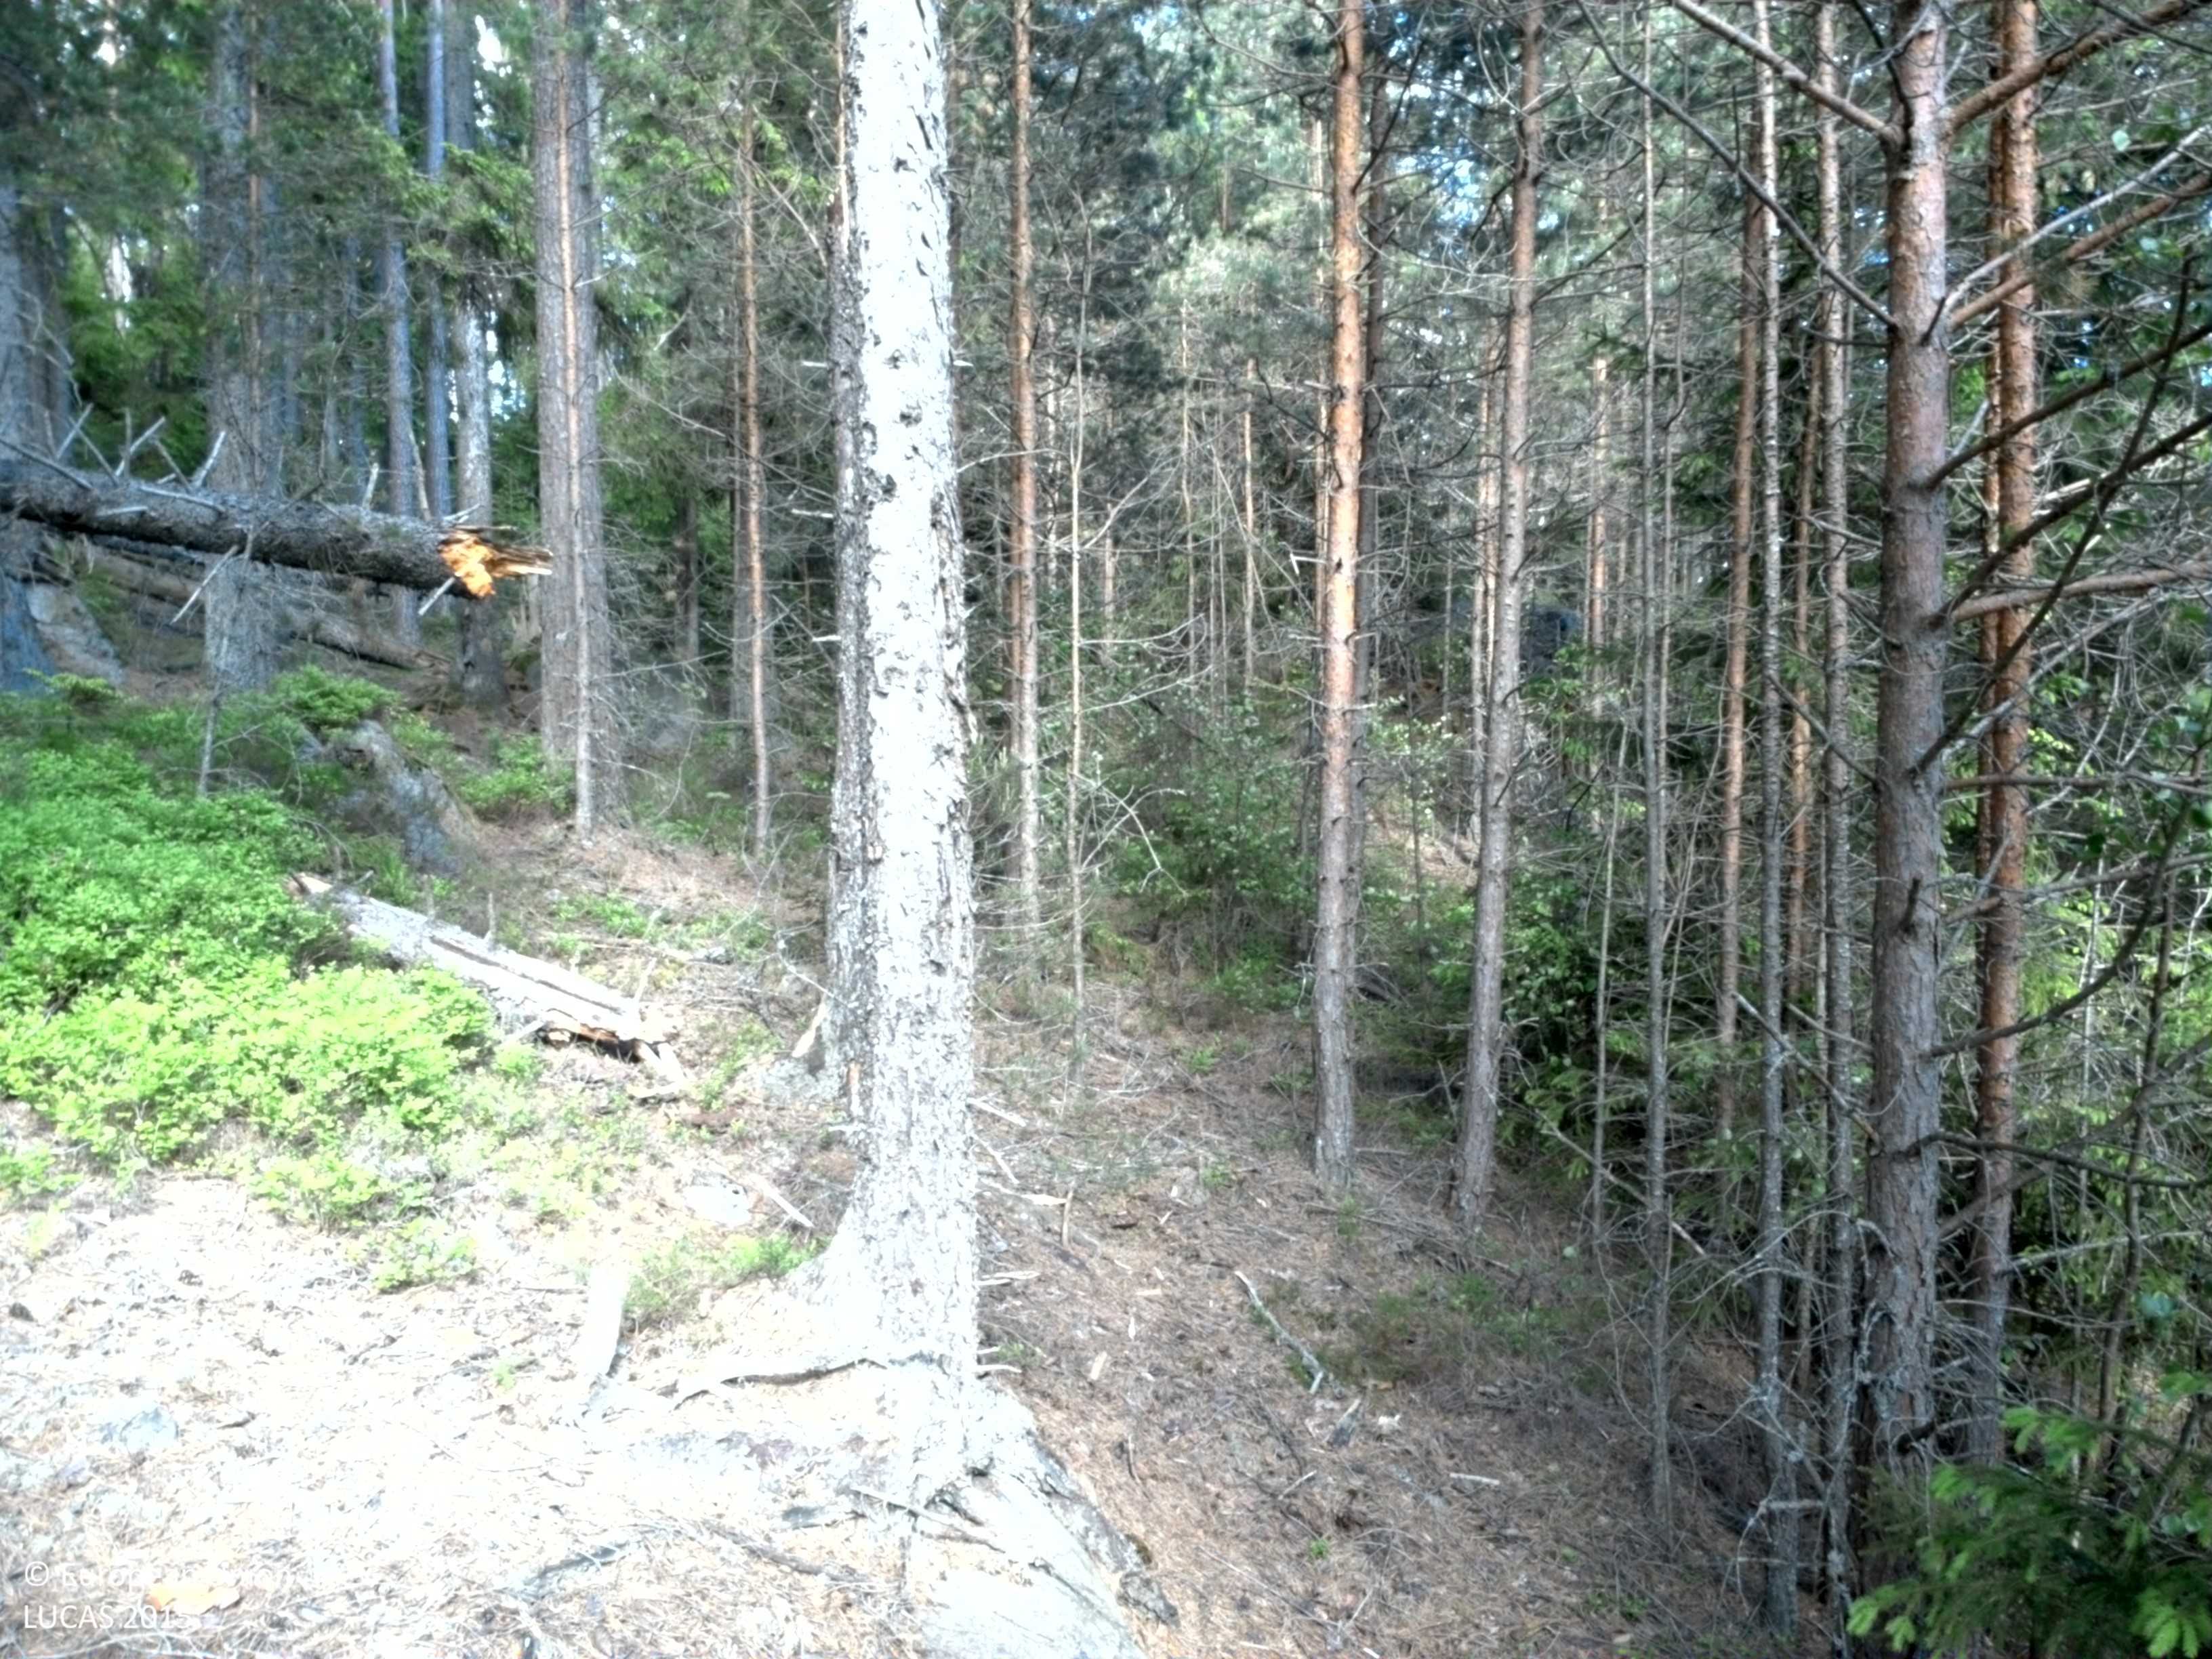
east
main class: Woodland
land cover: Other coniferous woodland
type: boreal forest
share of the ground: > 75 %
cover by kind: coniferous forest trees 80 %, broadleaved forest trees 5 %, shrubs 5 %, herbaceous plants 5 %, lichens and mosses 5 %
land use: Forestry
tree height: > 5 m
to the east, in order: Other coniferous woodland; Pine dominated coniferous woodland
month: June
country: SE
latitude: 58.7330
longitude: 14.6742
